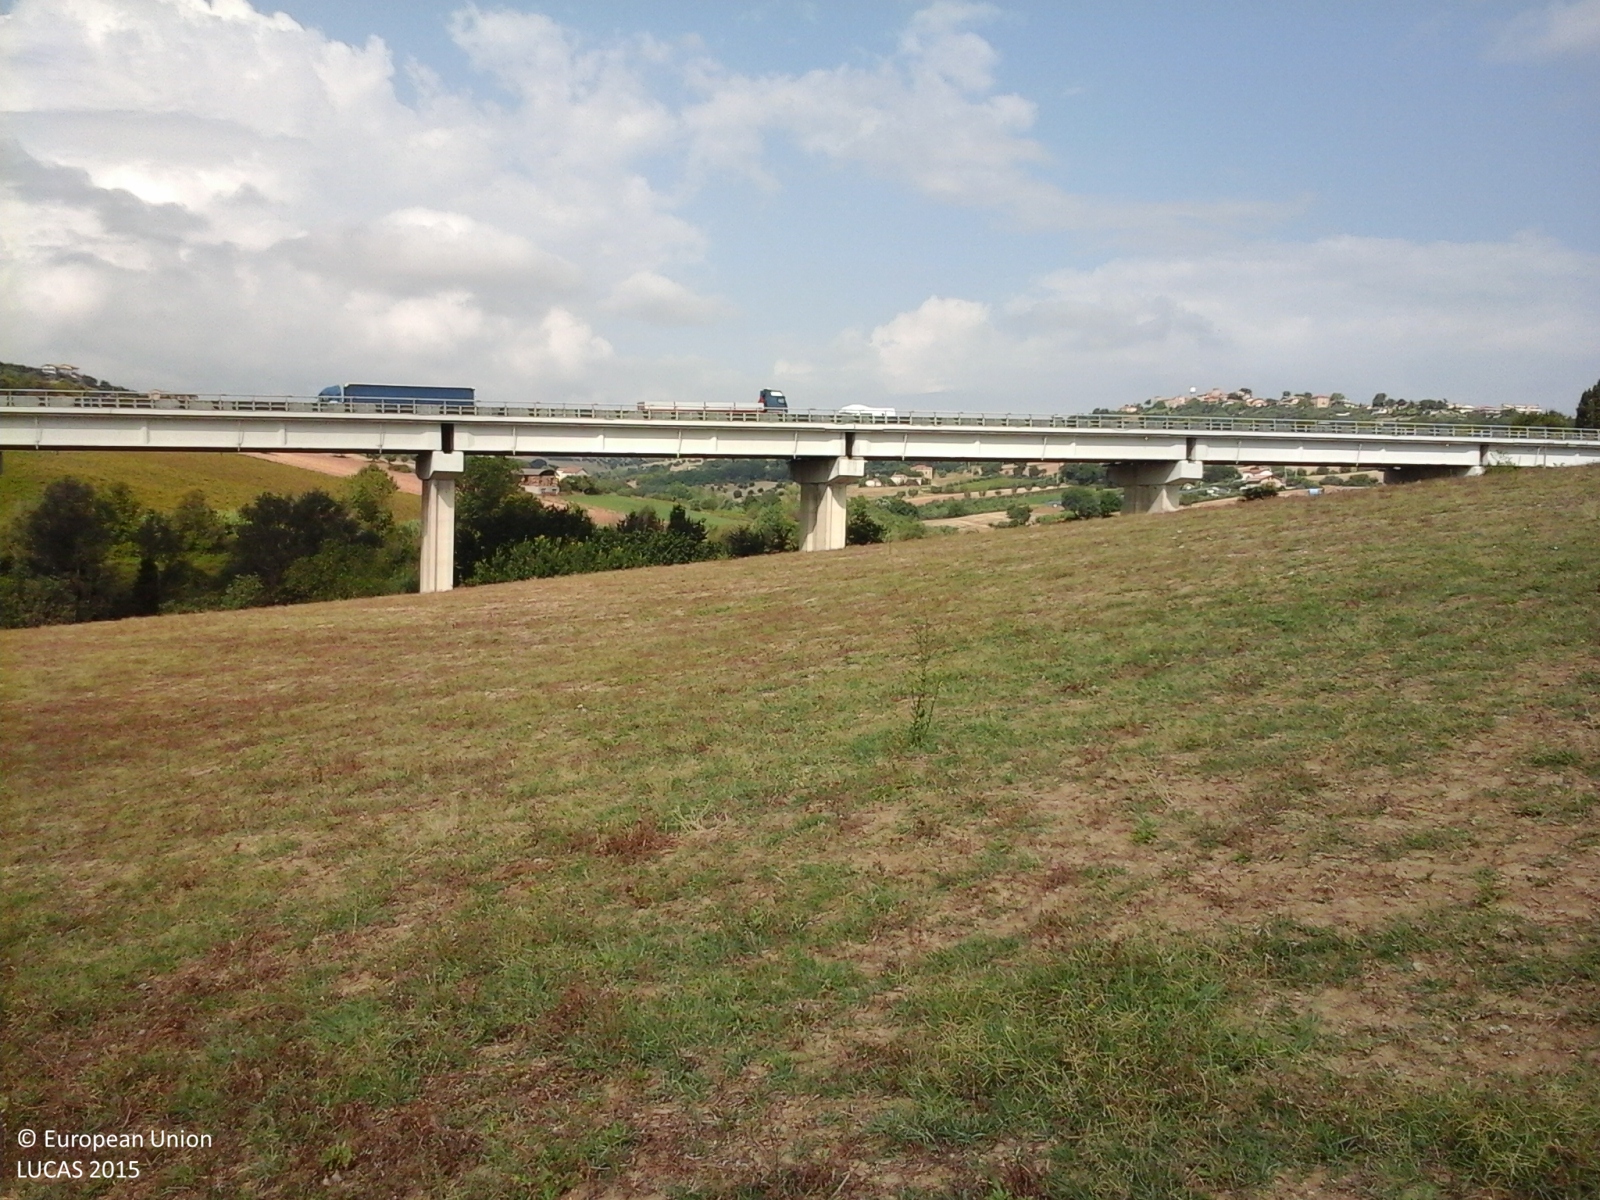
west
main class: Grassland
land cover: Spontaneously vegetated surfaces
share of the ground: > 75 %
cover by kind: herbaceous plants 100 %
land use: Agriculture (excluding fallow land and kitchen gardens)
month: August
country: IT
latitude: 42.7584
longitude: 13.9357
